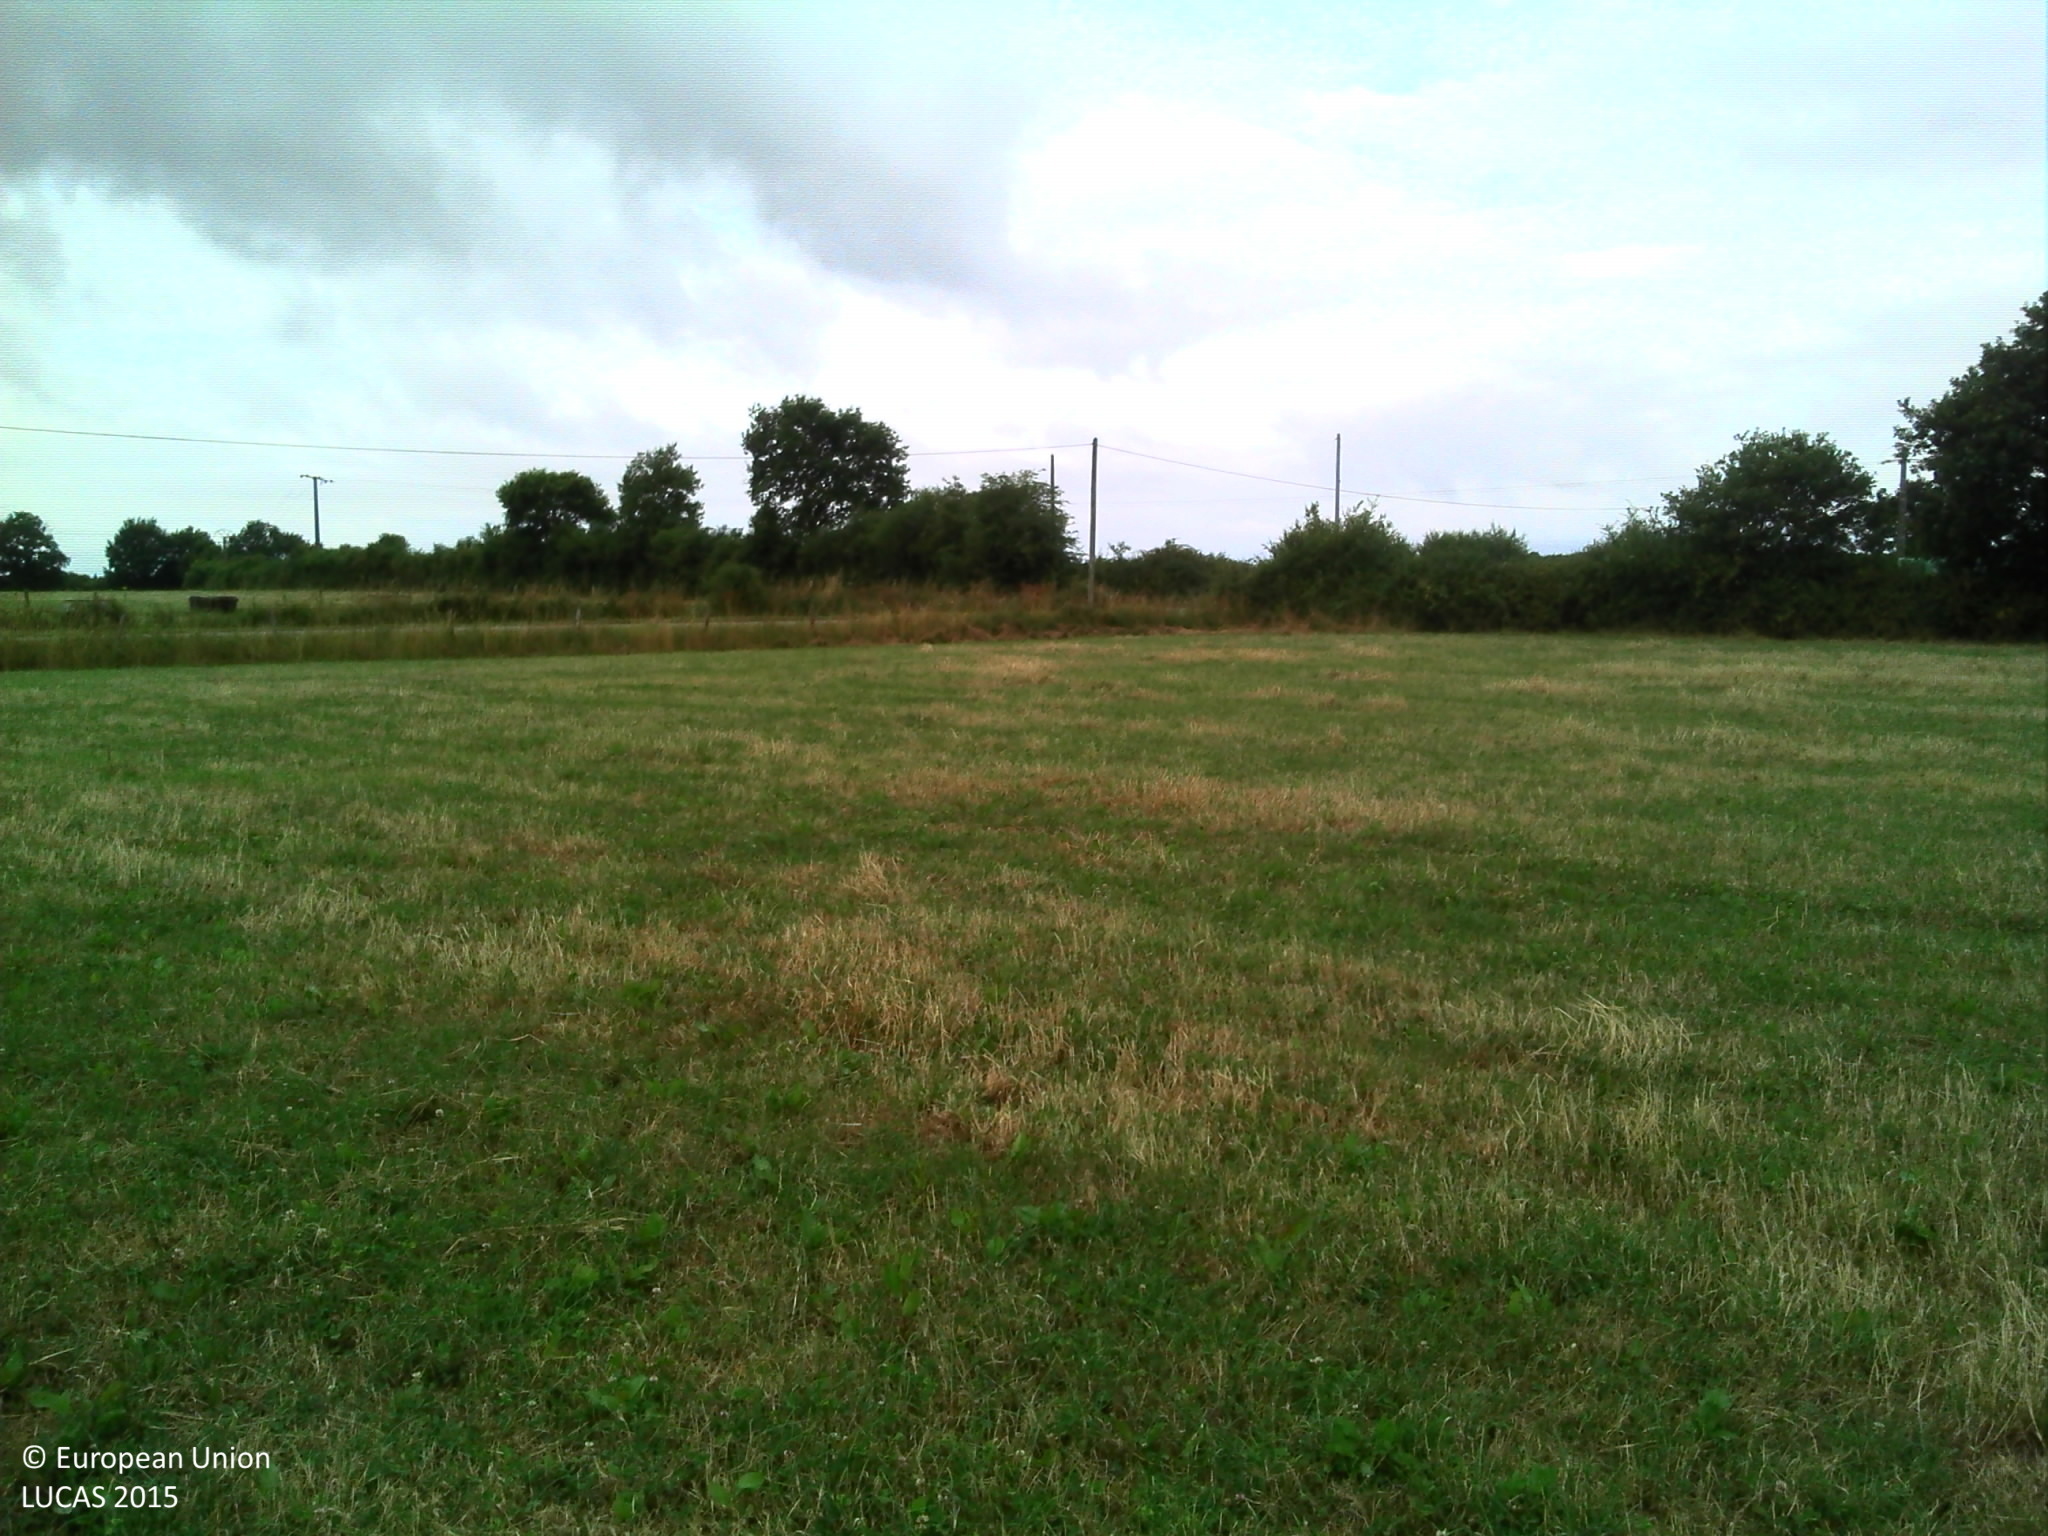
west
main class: Cropland
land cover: Temporary grasslands
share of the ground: > 75 %
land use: Agriculture (excluding fallow land and kitchen gardens)
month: July
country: FR
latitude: 47.1101
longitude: -1.8399
